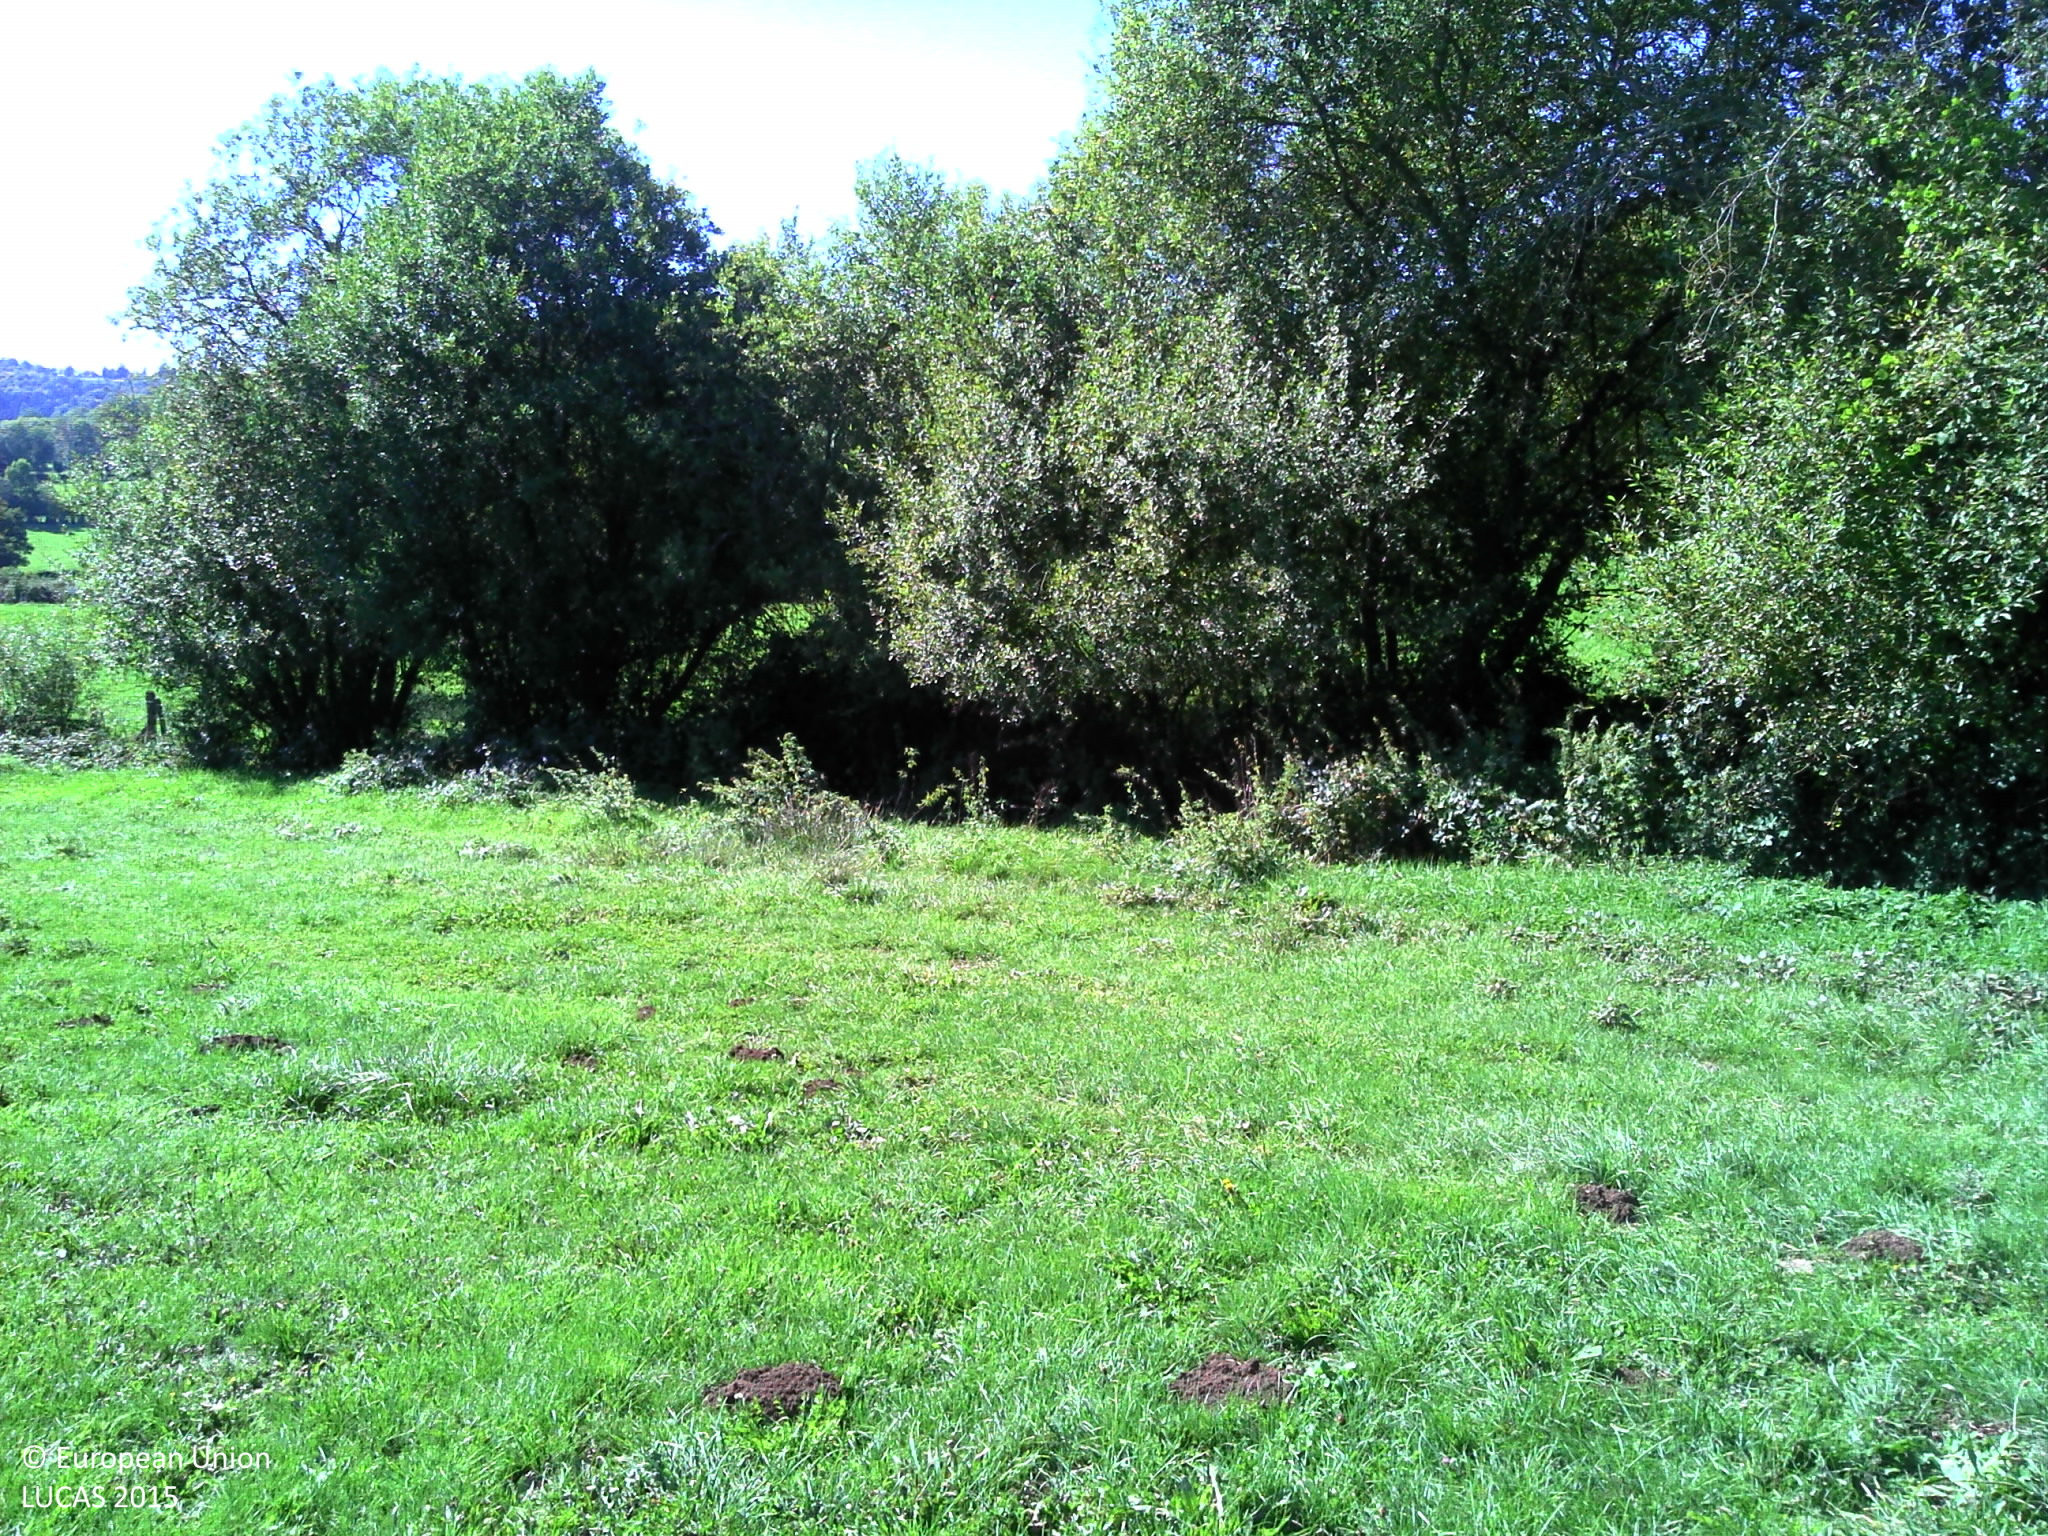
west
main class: Grassland
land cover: Grassland without tree/shrub cover
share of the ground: > 75 %
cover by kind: herbaceous plants 100 %
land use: Agriculture (excluding fallow land and kitchen gardens)
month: September
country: FR
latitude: 45.8211
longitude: 2.8295
